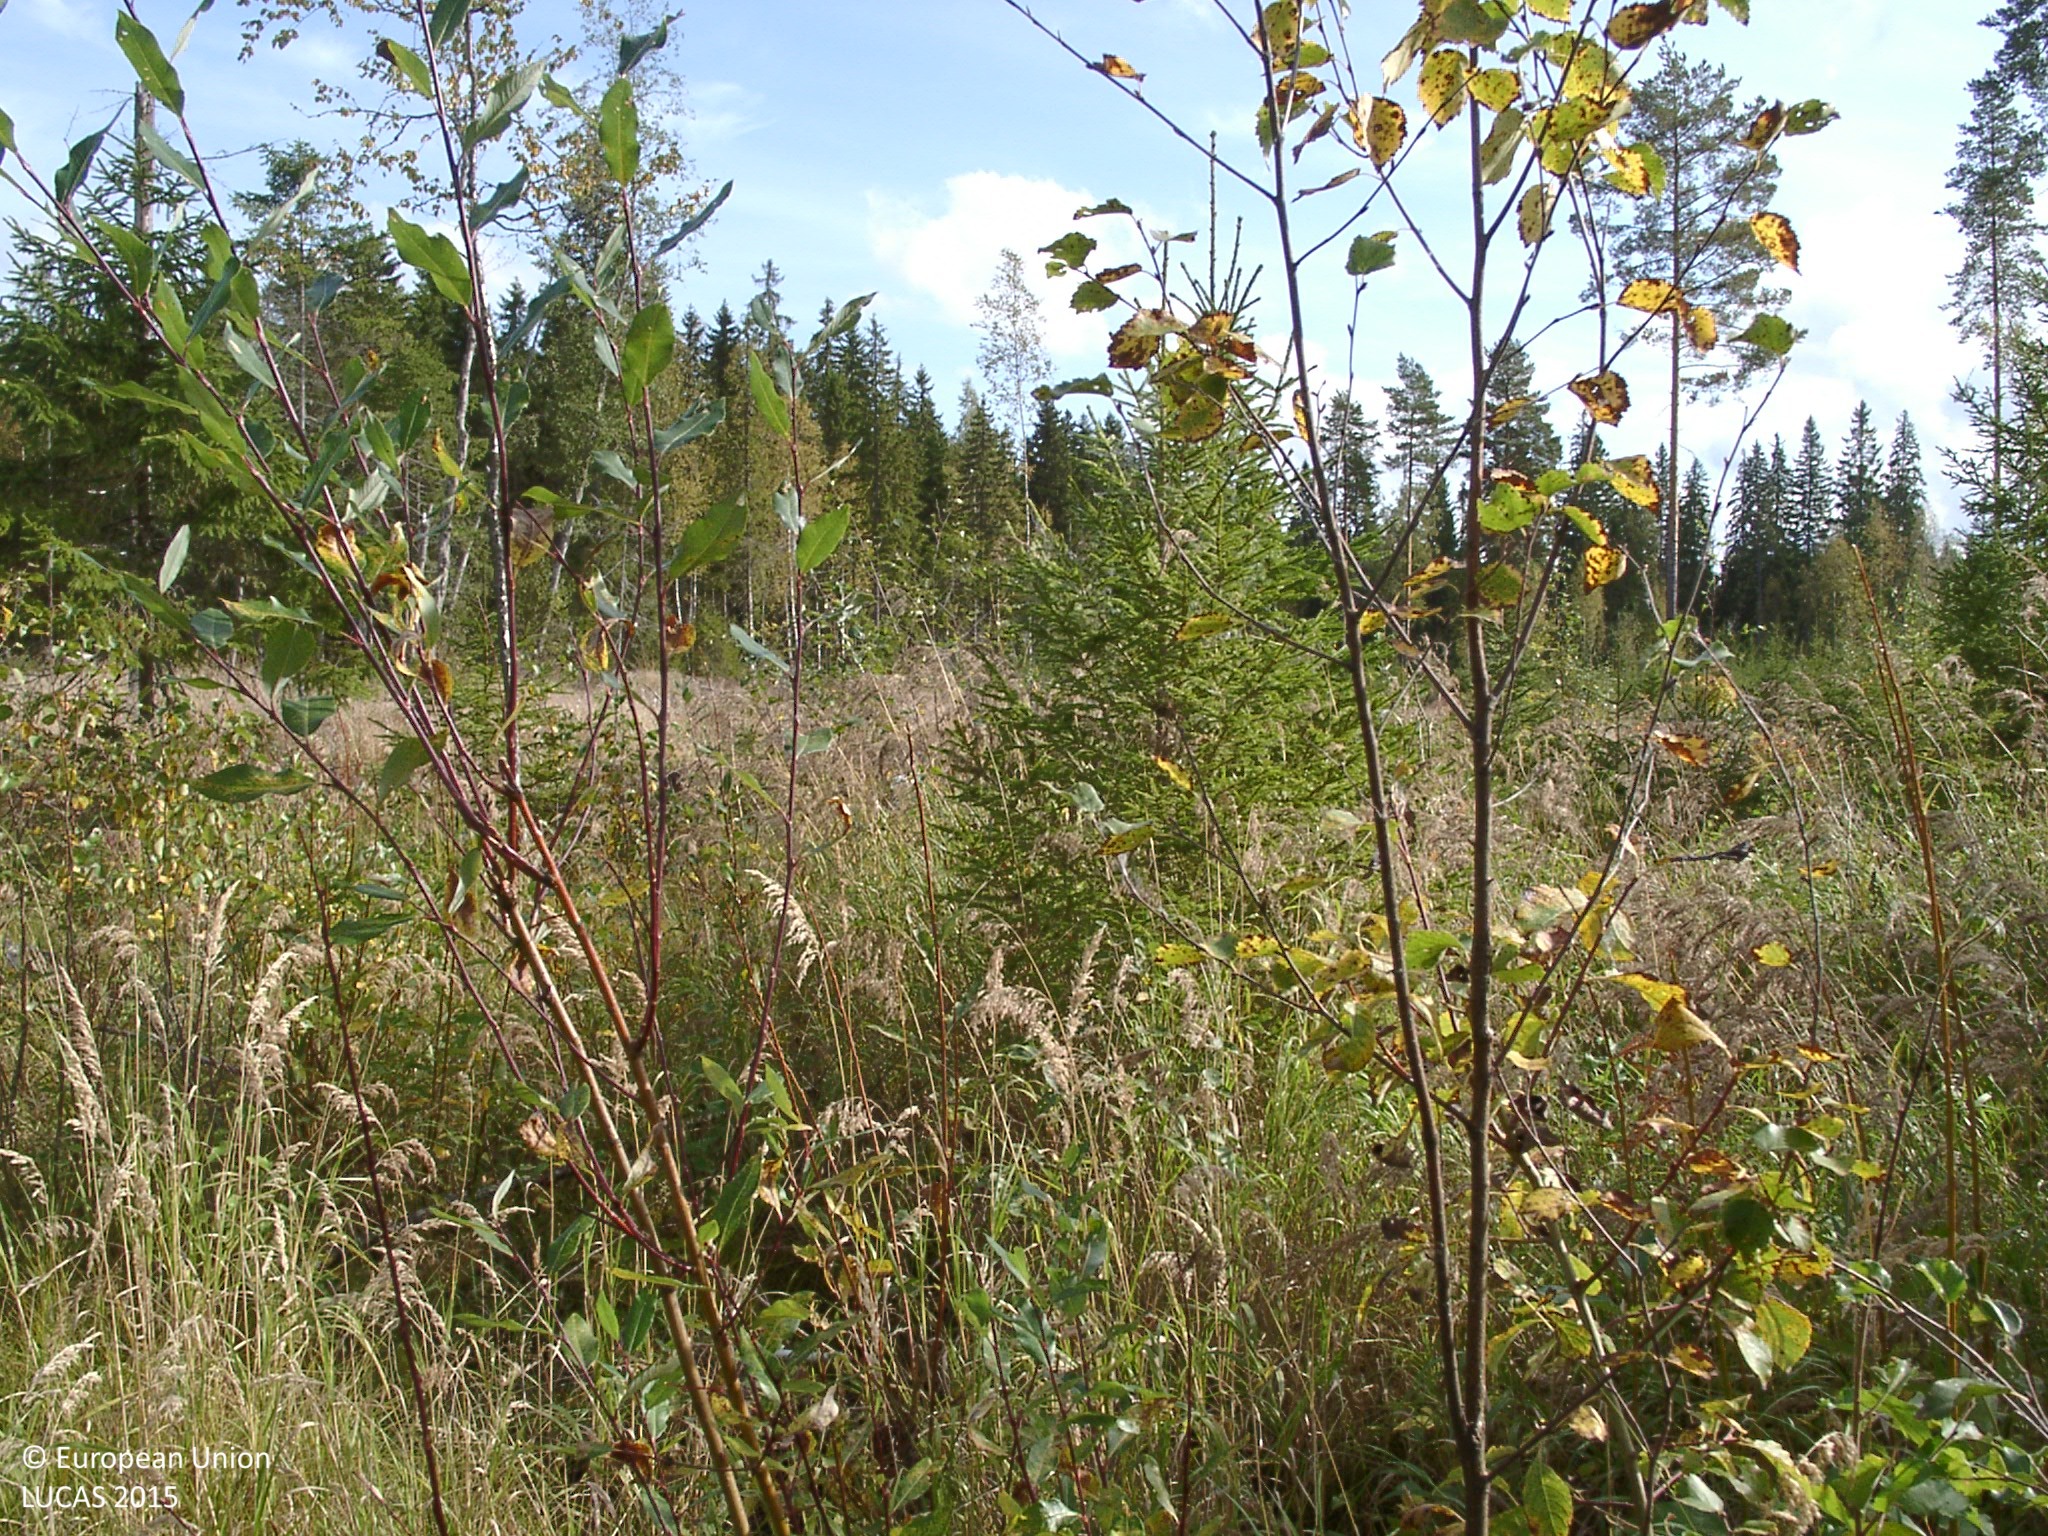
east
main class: Woodland
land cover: Spruce dominated mixed woodland
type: boreal forest
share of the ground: 10 - 25 %
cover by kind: herbaceous plants 75 %, lichens and mosses 10 %, coniferous forest trees 5 %, broadleaved forest trees 5 %, shrubs 5 %
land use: Forestry
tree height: < 5 m
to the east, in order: Spruce dominated mixed woodland; Shrubland with sparse tree cover; Shrubland without tree cover; Spruce dominated coniferous woodland; Spruce dominated mixed woodland; Spruce dominated coniferous woodland; Spruce dominated mixed woodland
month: September
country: FI
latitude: 62.5231
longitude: 25.8367
